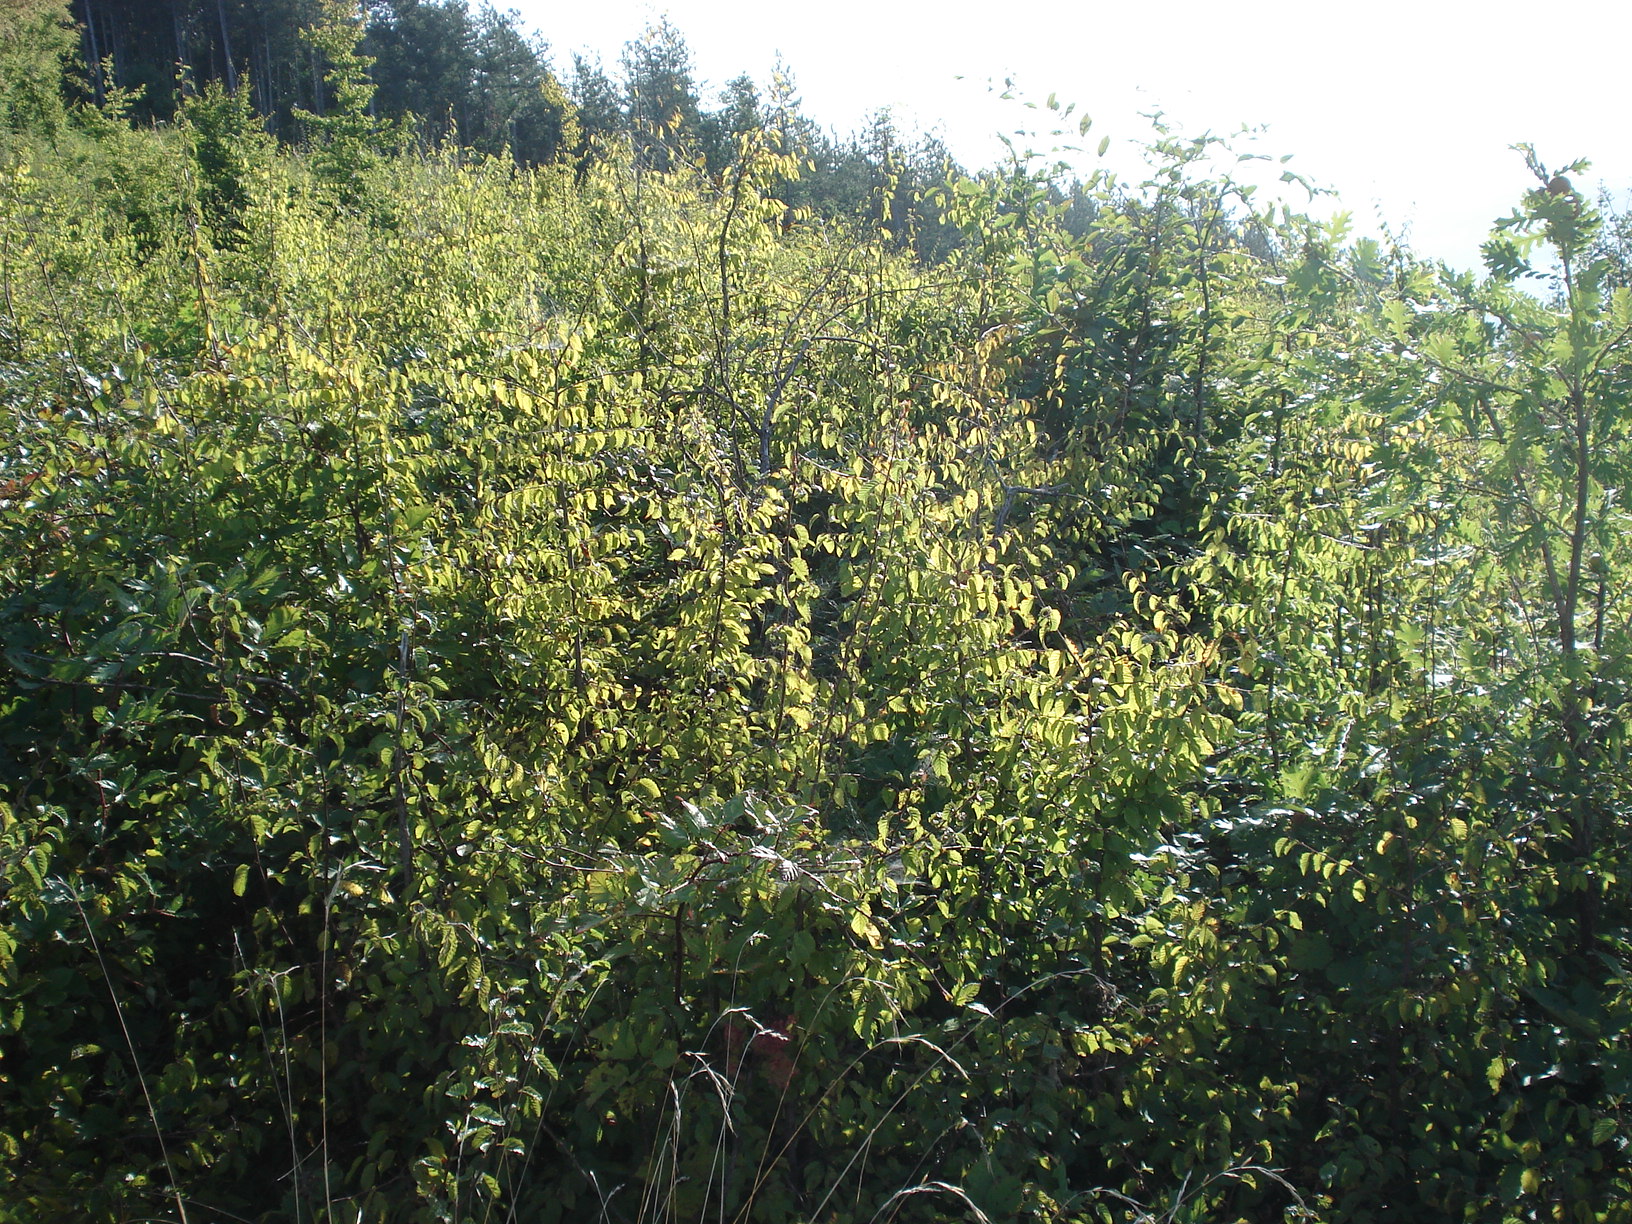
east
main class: Woodland
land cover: Pine dominated mixed woodland
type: hemiboreal forest and nemoral coniferous forest and mixed broadleaved-coniferous forest
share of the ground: 50 - 75 %
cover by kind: coniferous forest trees 35 %, broadleaved forest trees 35 %, shrubs 20 %, herbaceous plants 10 %
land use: Forestry
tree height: < 5 m
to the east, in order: Pine dominated mixed woodland; Pine dominated coniferous woodland
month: September
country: BG
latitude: 42.9224
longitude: 25.7248
